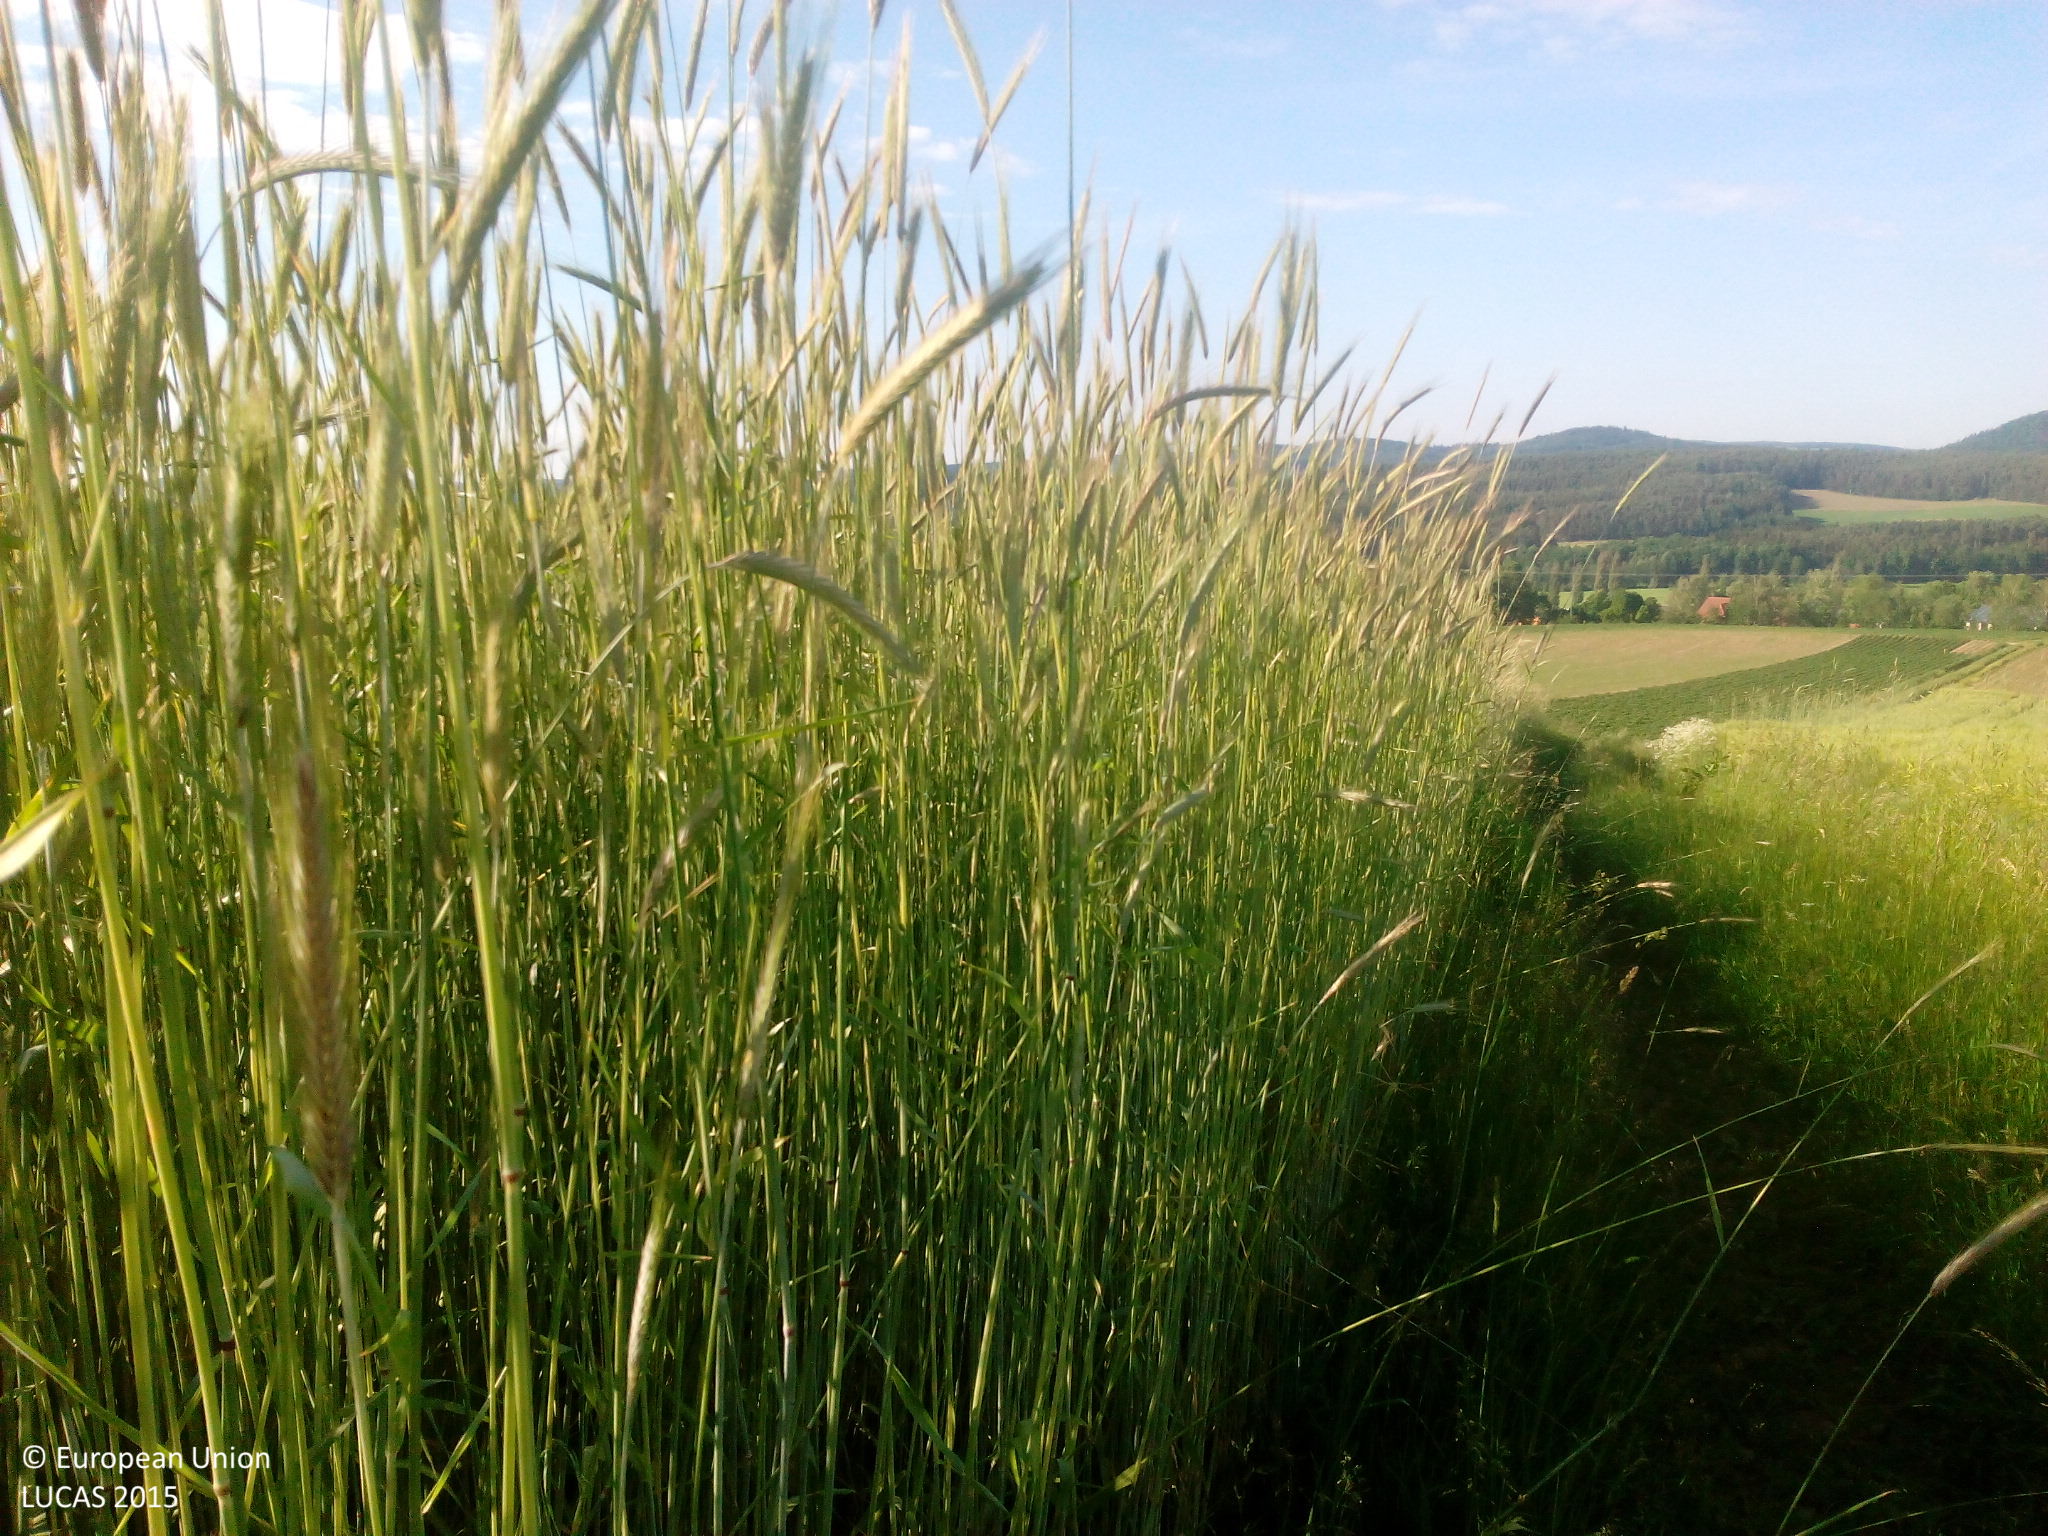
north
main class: Cropland
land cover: Rye
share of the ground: > 75 %
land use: Agriculture (excluding fallow land and kitchen gardens)
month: June
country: DE
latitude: 49.3503
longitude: 12.3535
